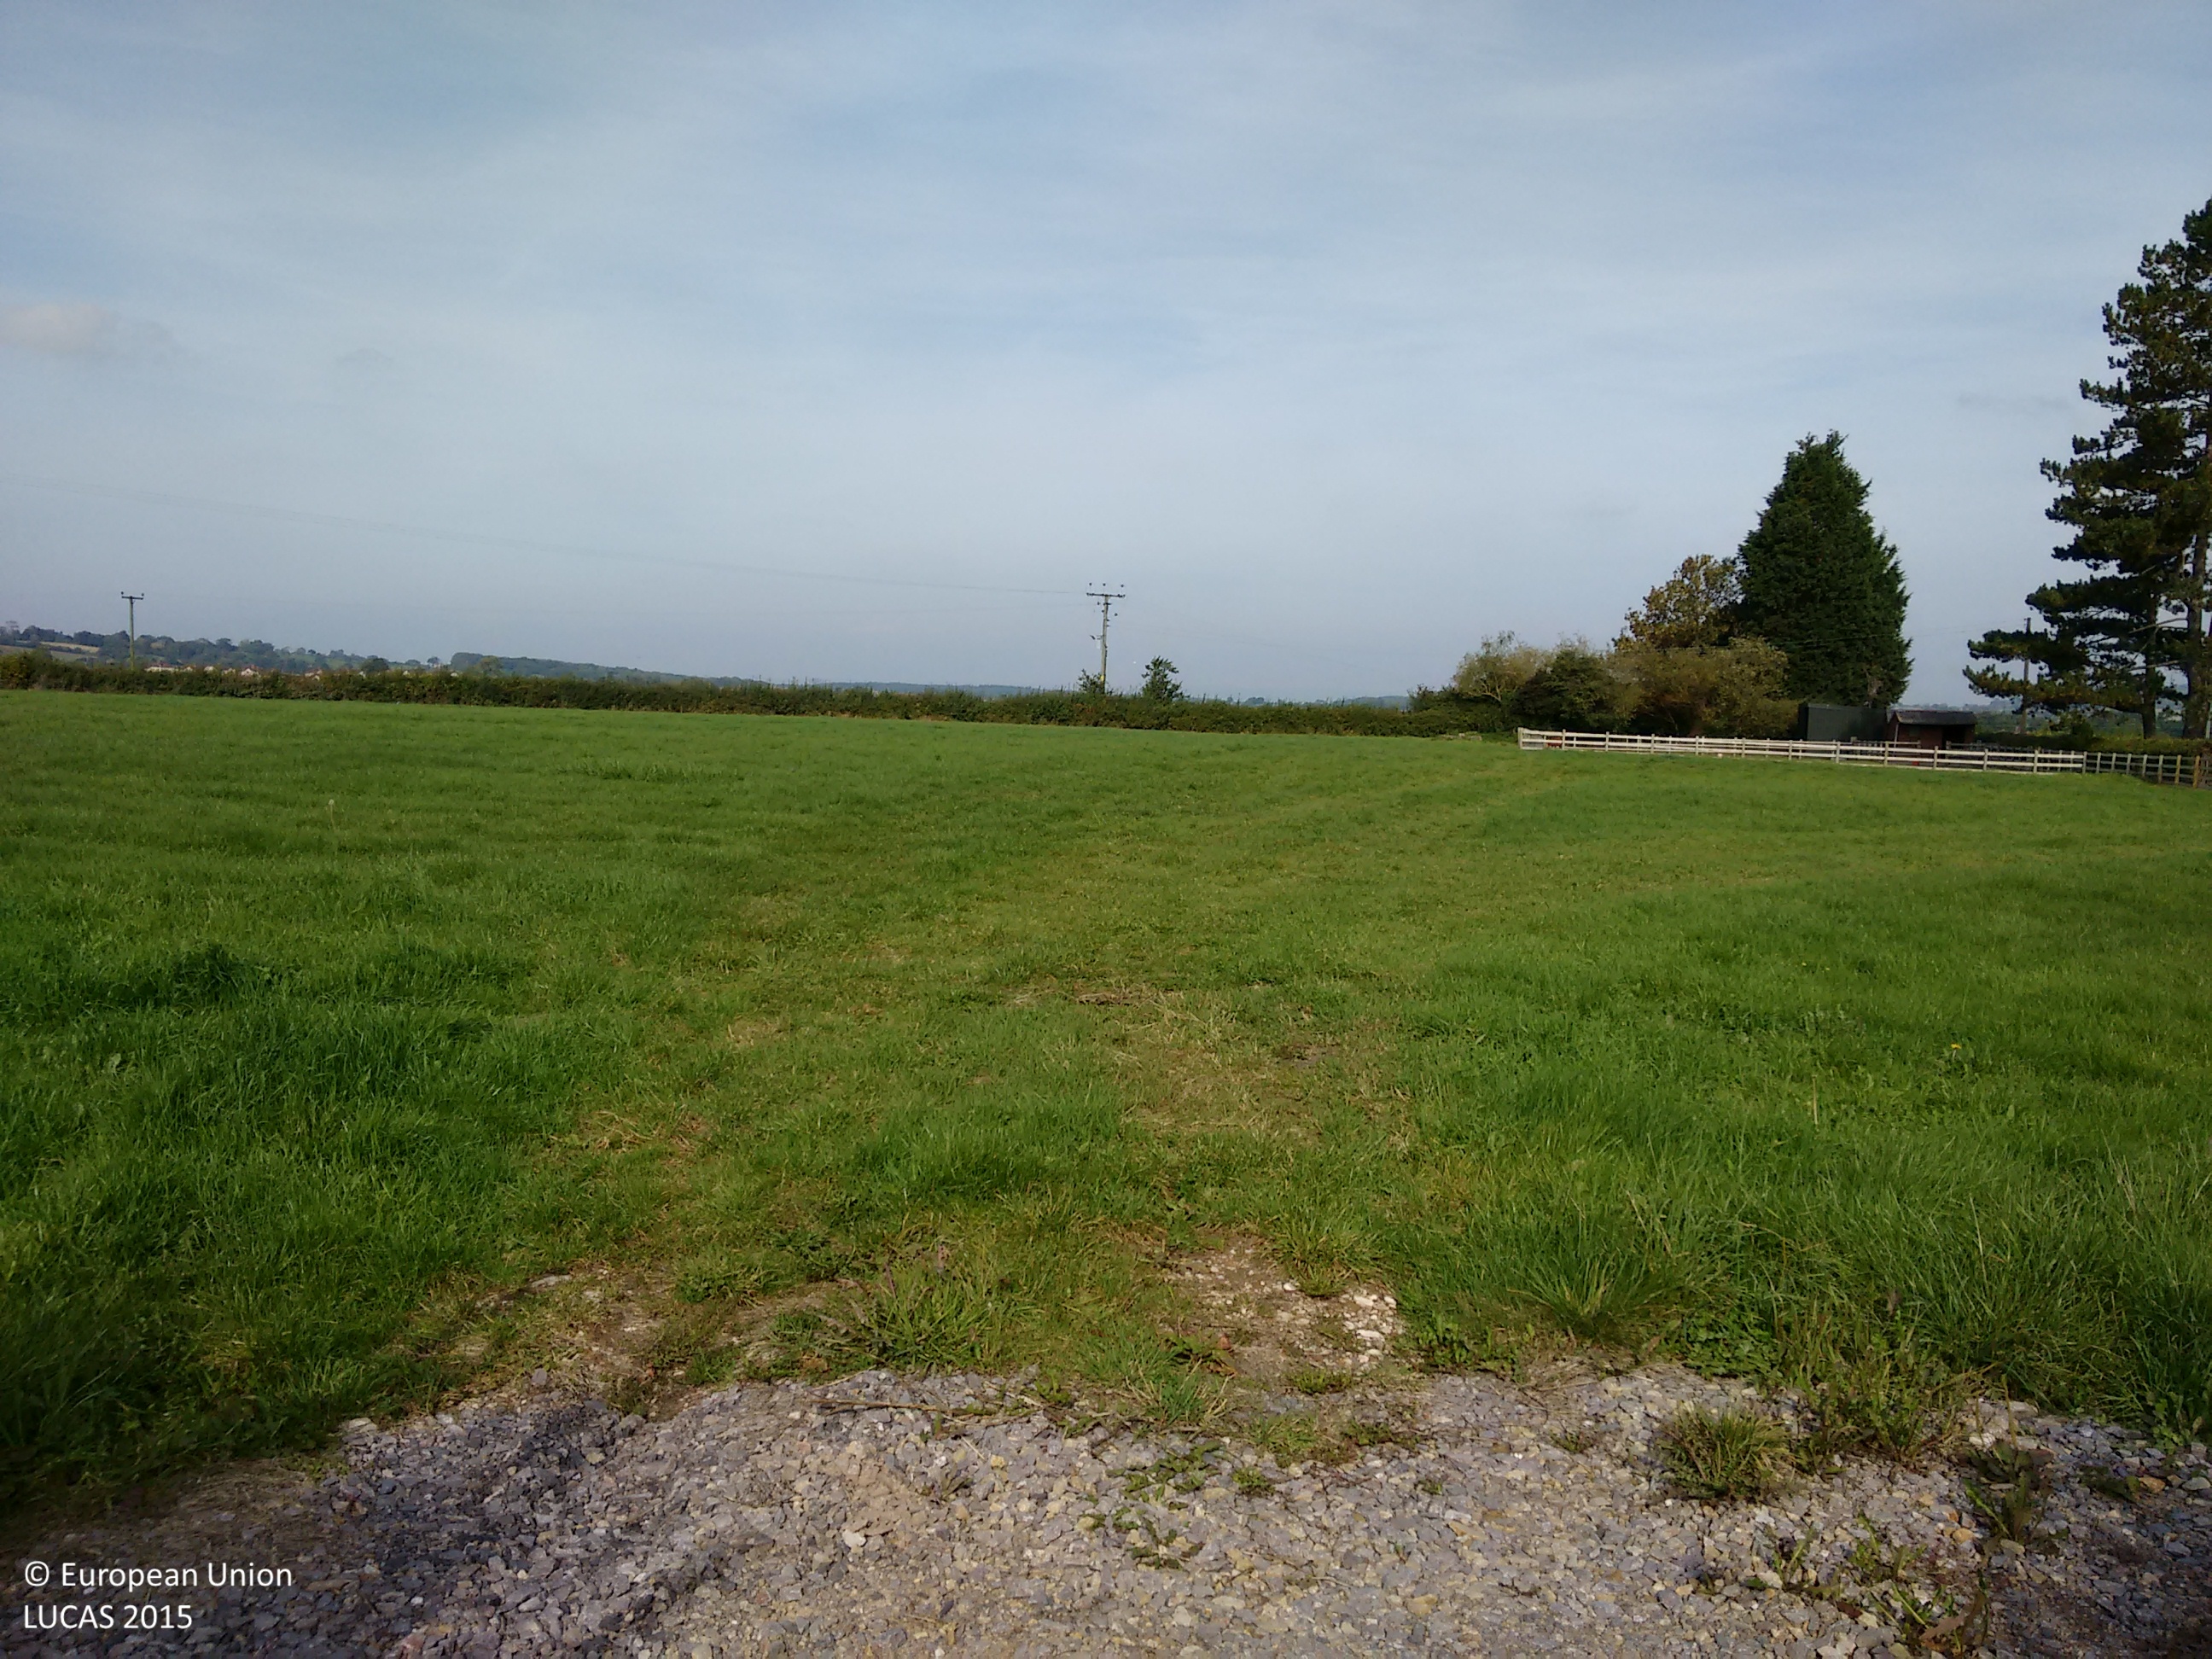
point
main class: Grassland
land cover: Grassland without tree/shrub cover
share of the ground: > 75 %
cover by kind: herbaceous plants 100 %
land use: Agriculture (excluding fallow land and kitchen gardens)
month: September
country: GB
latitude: 51.6167
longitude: -2.3840
